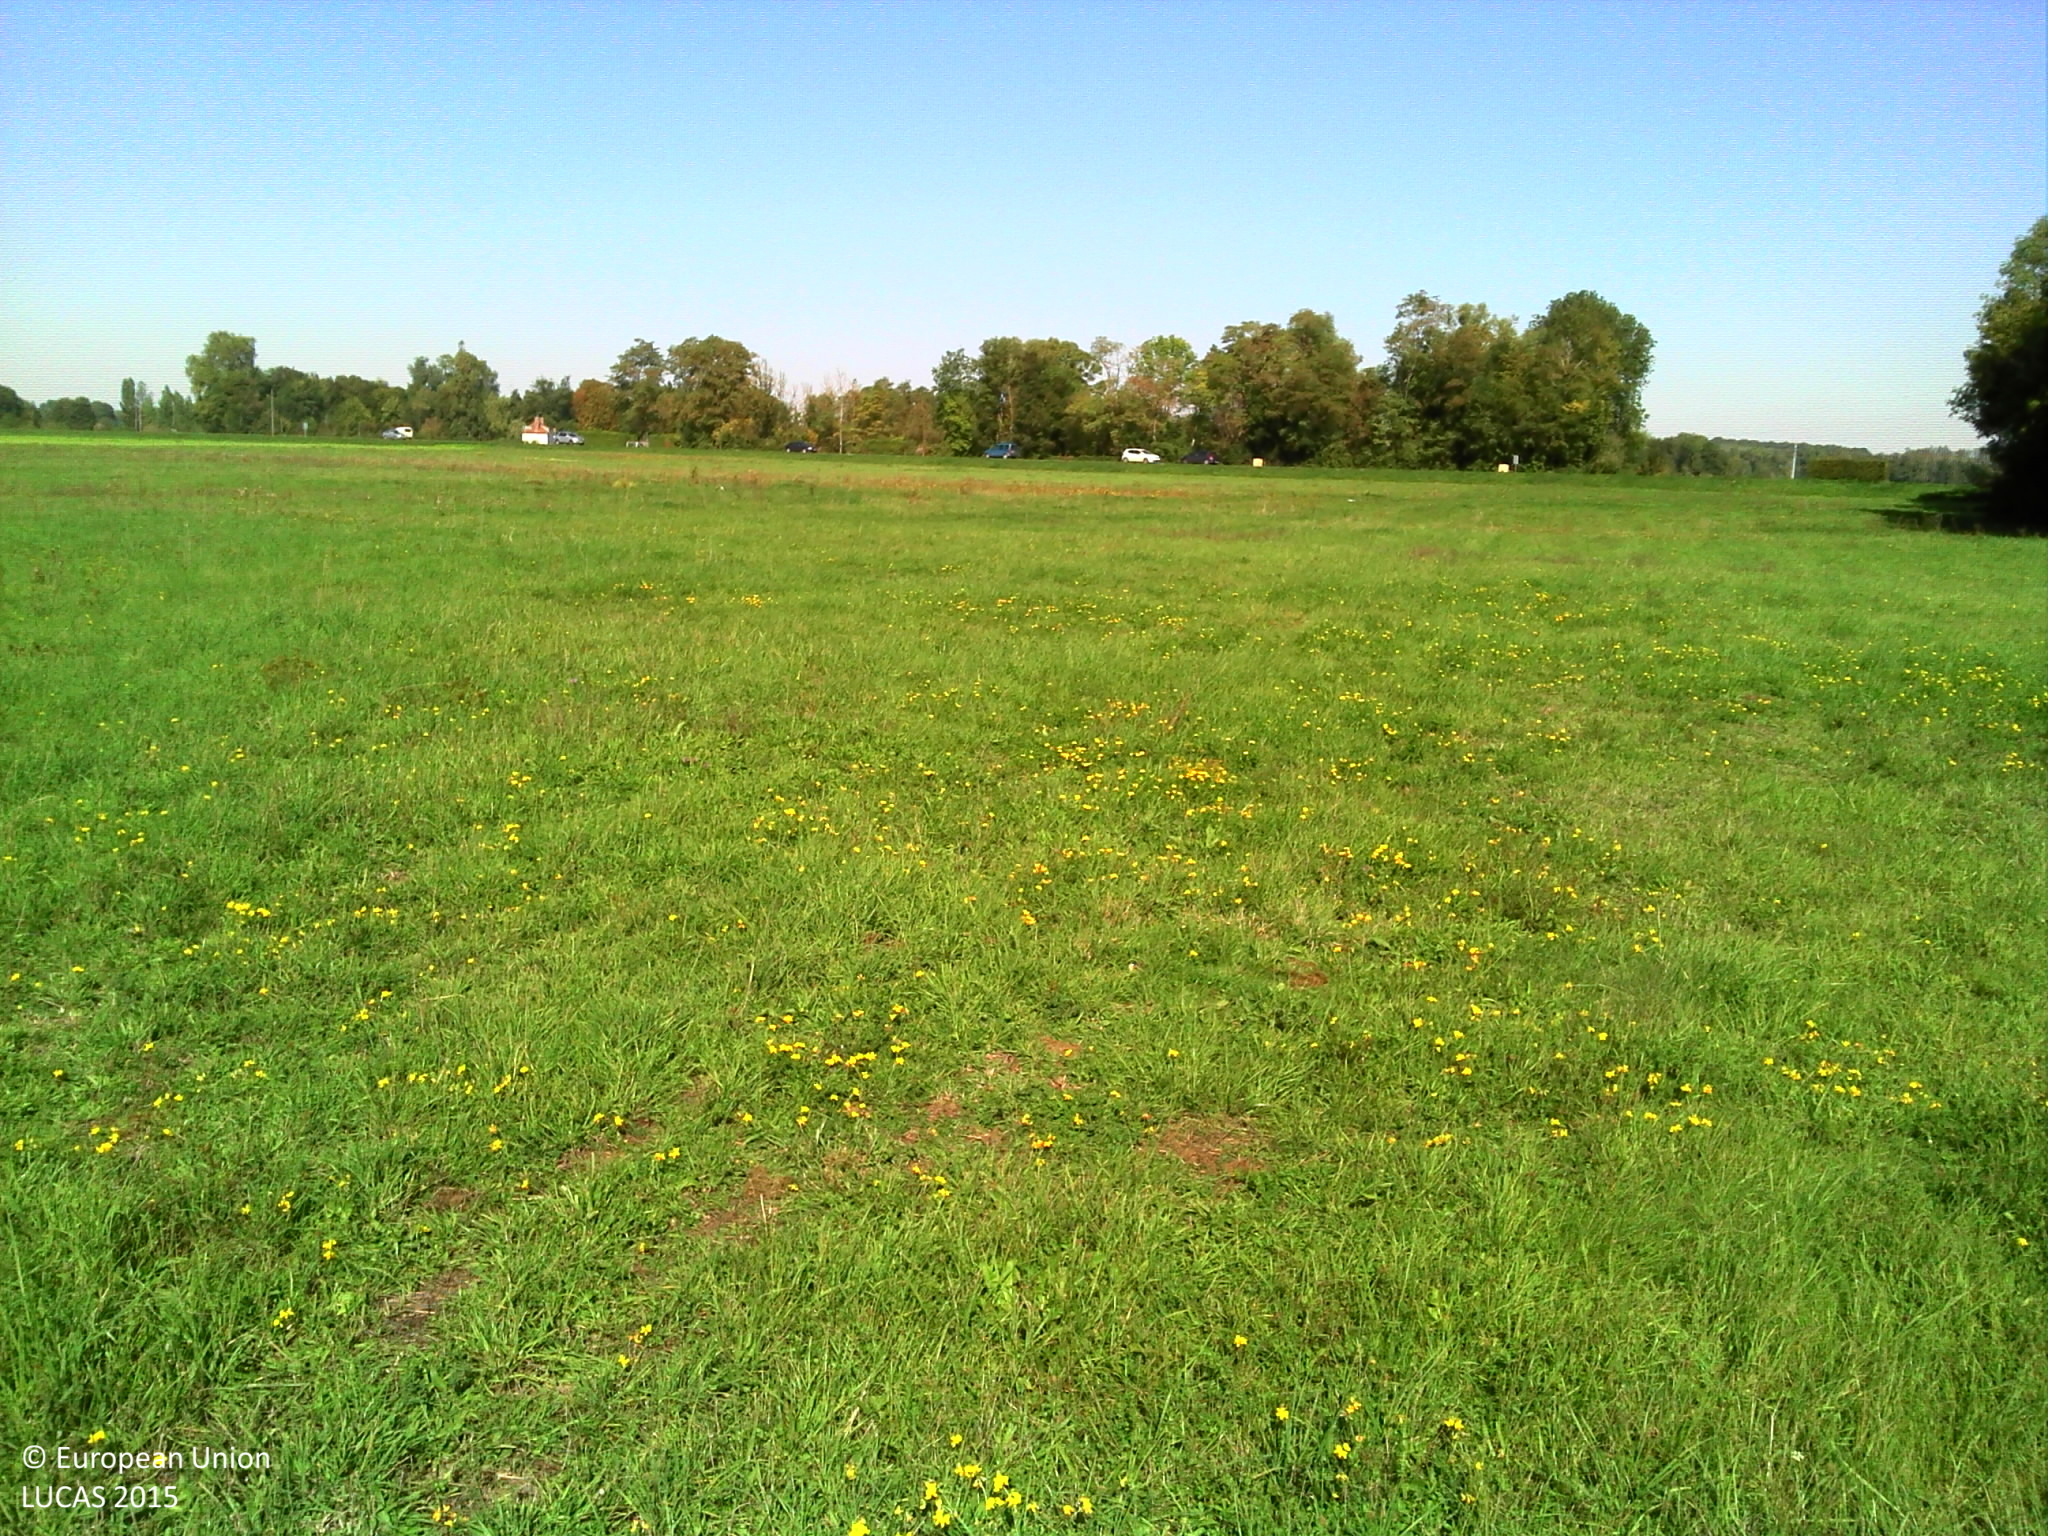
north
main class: Cropland
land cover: Temporary grasslands
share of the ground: > 75 %
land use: Agriculture (excluding fallow land and kitchen gardens)
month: September
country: FR
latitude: 48.1791
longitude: 4.2004
